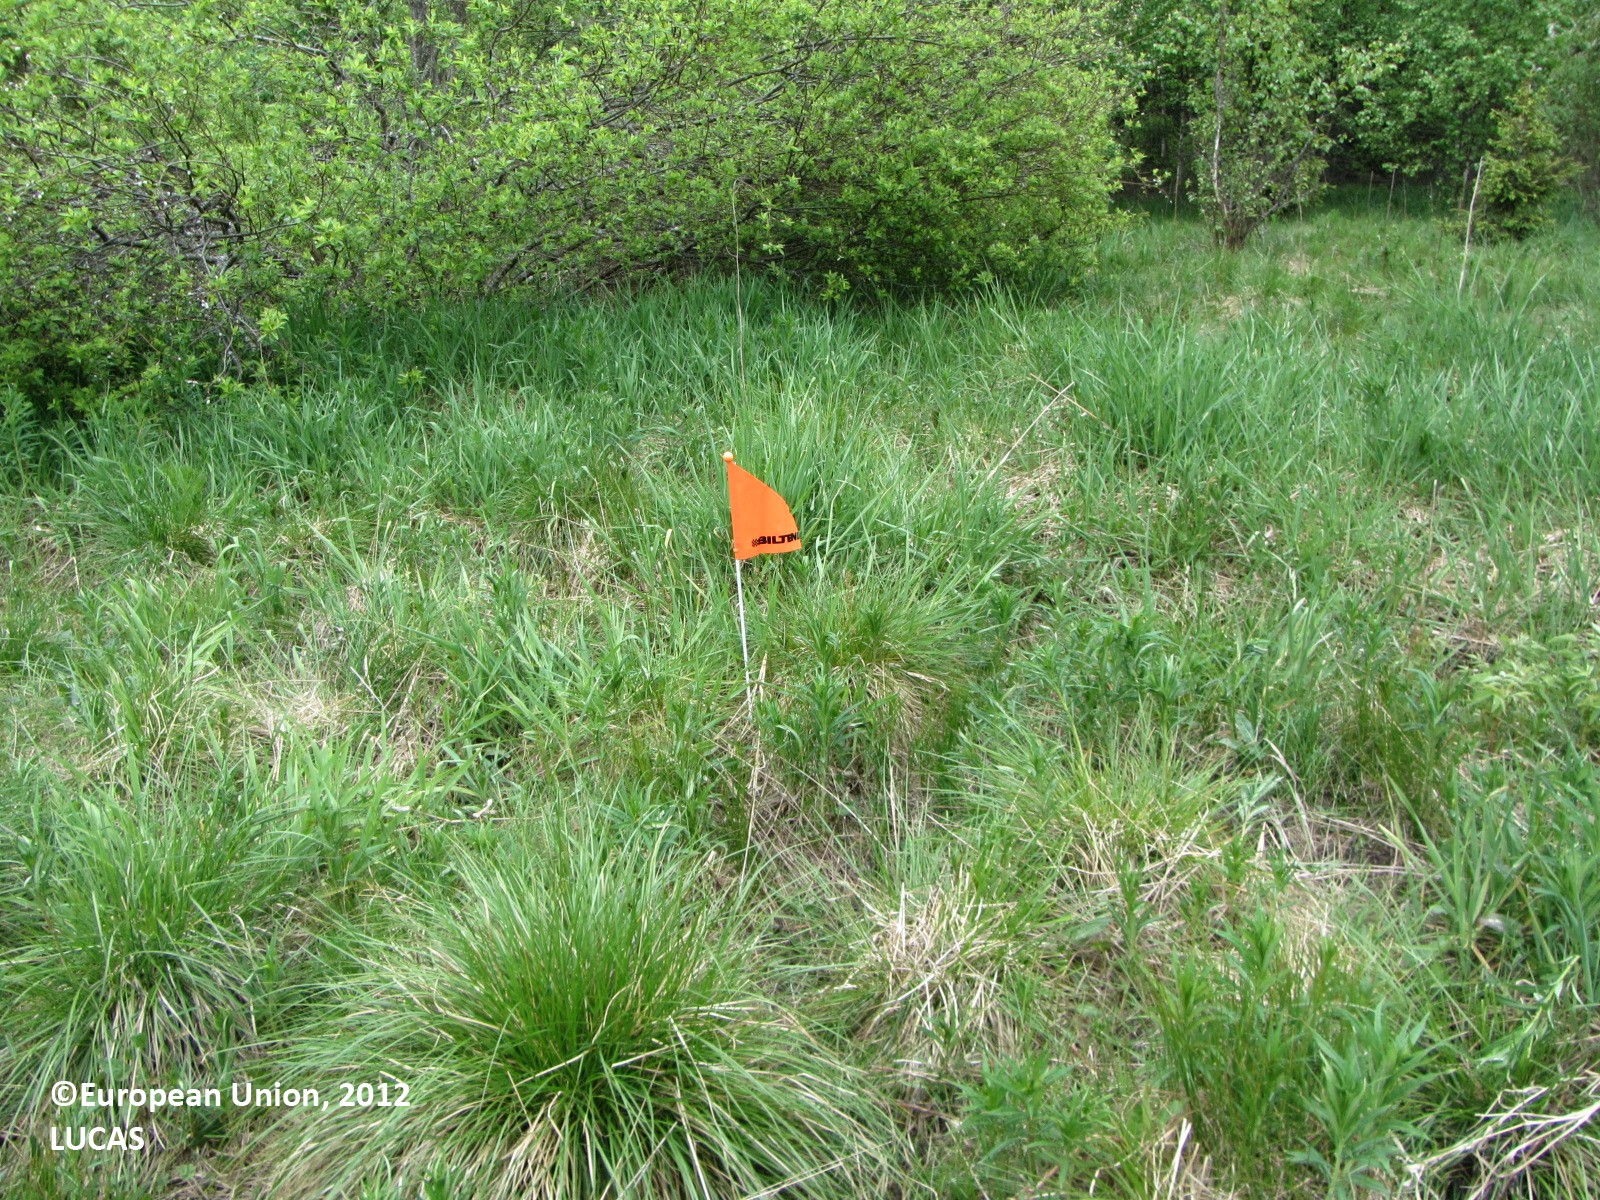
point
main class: Grassland
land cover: Grassland with sparse tree/shrub cover
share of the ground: > 75 %
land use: Semi-natural and natural areas not in use
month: June
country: FI
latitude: 61.6844
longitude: 24.8646
